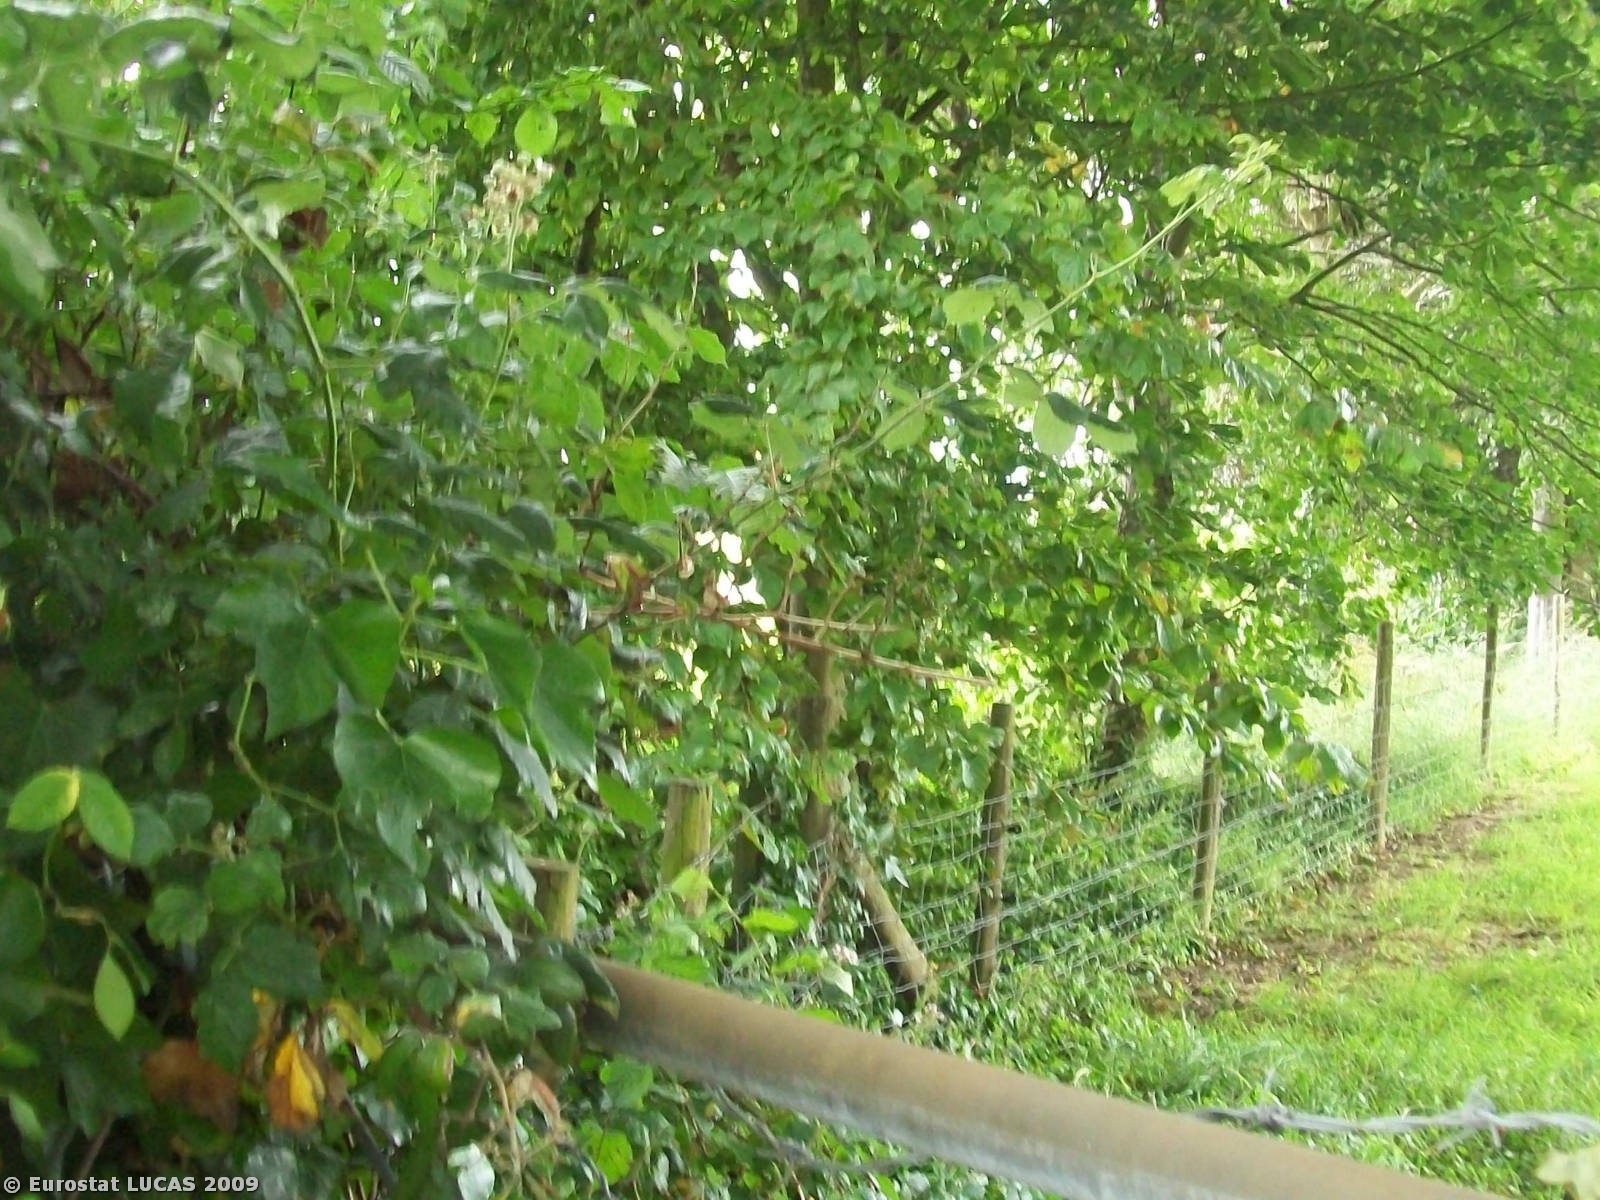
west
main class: Grassland
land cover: Grassland without tree/shrub cover
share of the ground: > 75 %
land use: Agriculture (excluding fallow land and kitchen gardens)
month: July
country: GB
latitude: 50.7384
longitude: -2.0898
